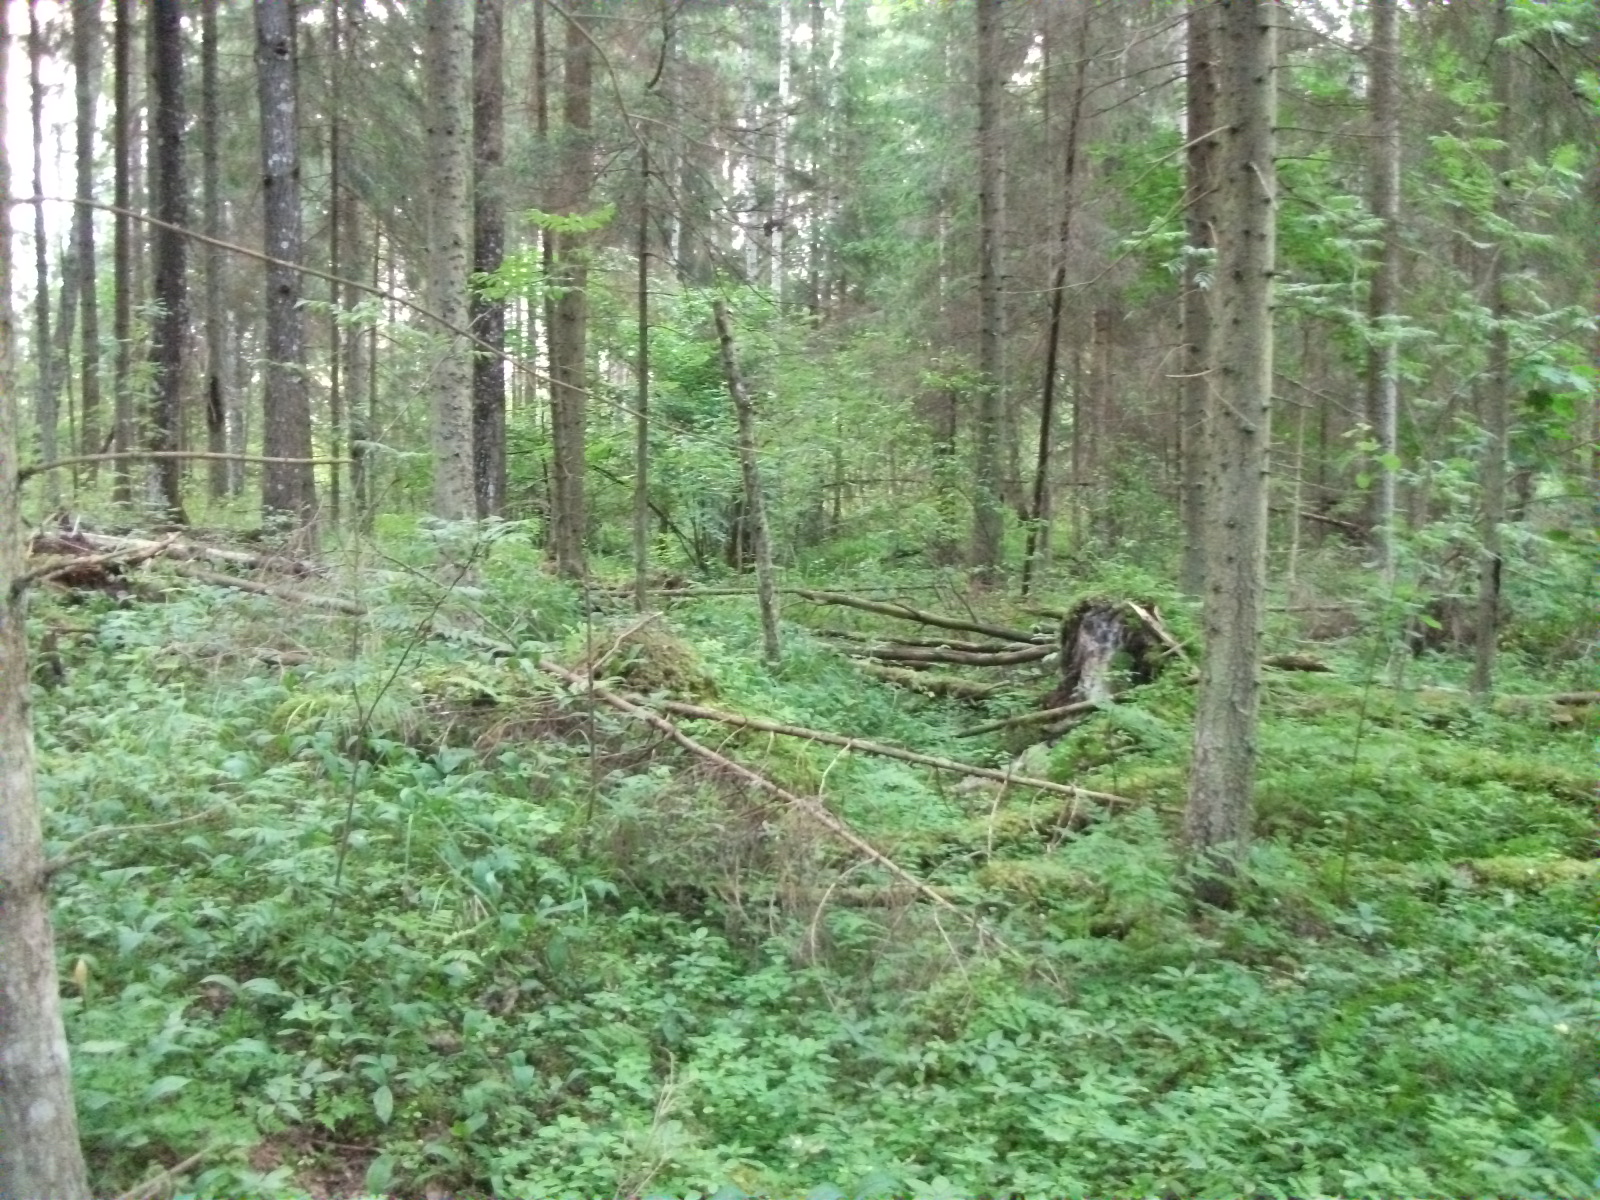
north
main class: Woodland
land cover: Spruce dominated mixed woodland
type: hemiboreal forest and nemoral coniferous forest and mixed broadleaved-coniferous forest
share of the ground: > 75 %
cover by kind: coniferous forest trees 60 %, broadleaved forest trees 25 %, shrubs 5 %, herbaceous plants 5 %, lichens and mosses 5 %
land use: Forestry
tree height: > 5 m
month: July
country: LV
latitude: 57.1382
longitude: 26.3163
